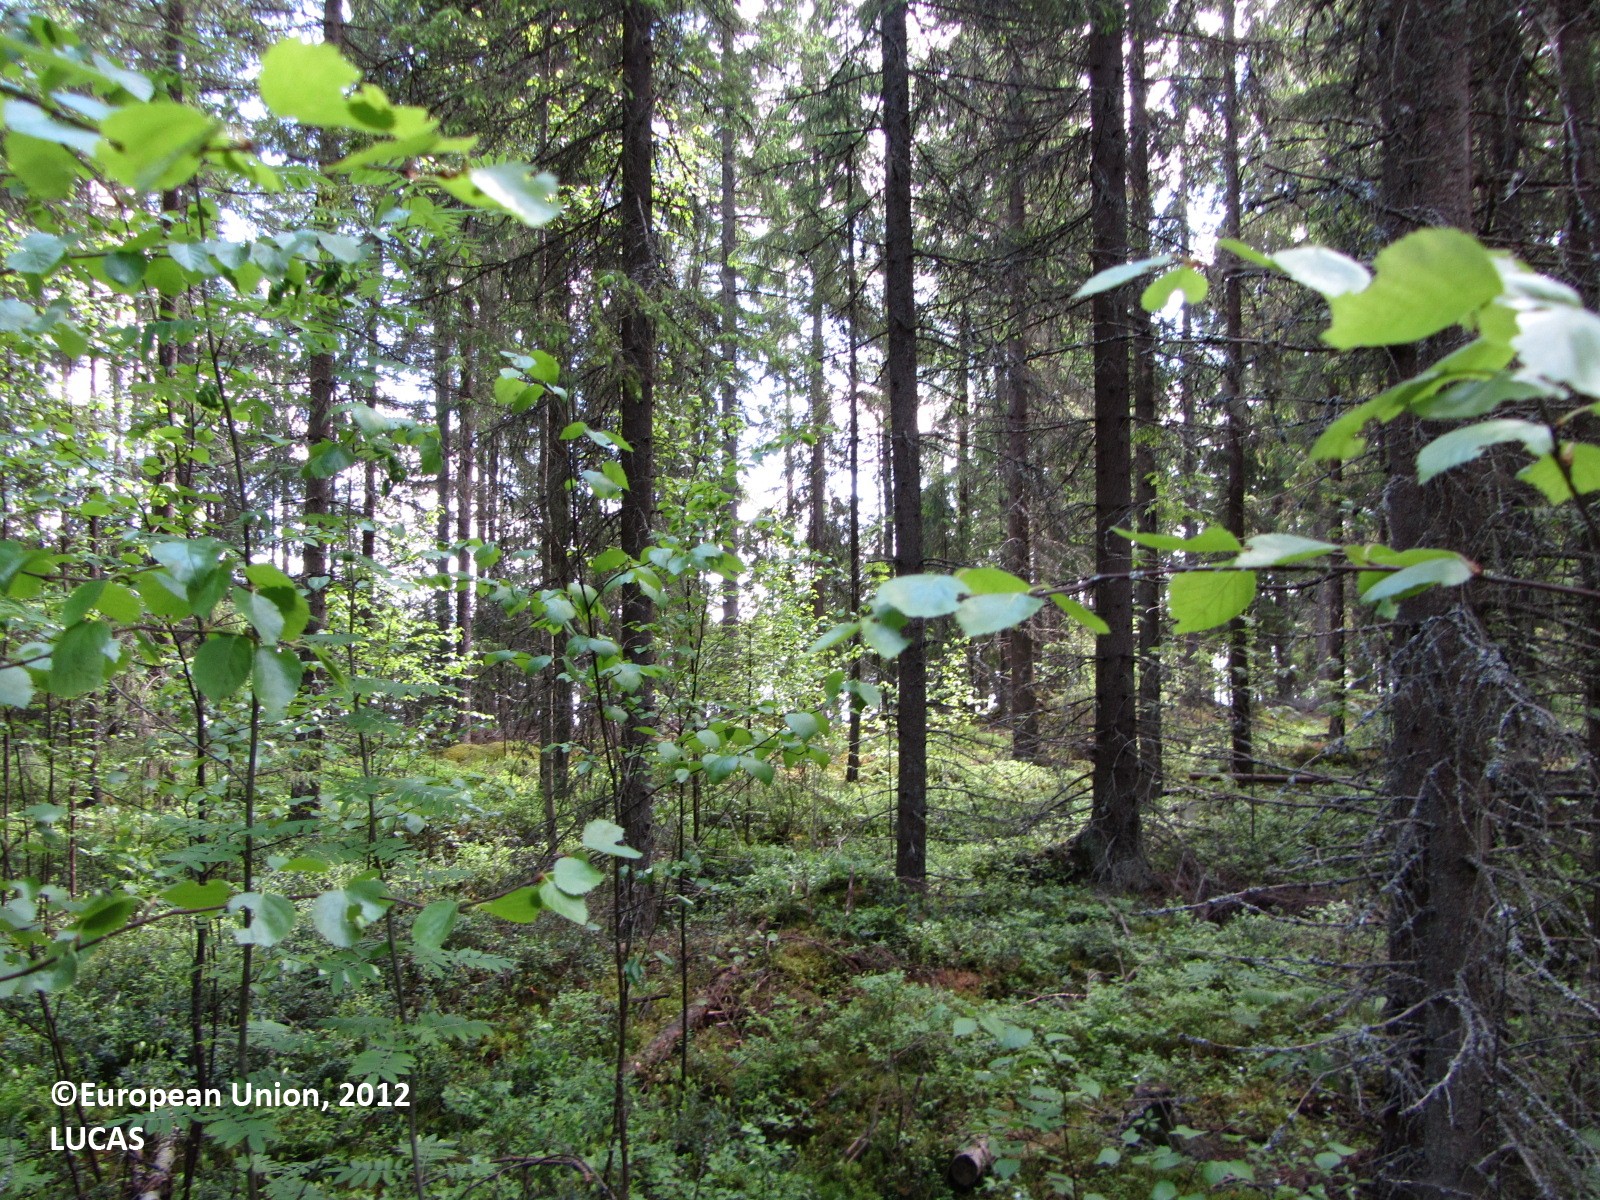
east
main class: Woodland
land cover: Spruce dominated mixed woodland
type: boreal forest
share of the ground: 50 - 75 %
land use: Forestry
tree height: > 5 m
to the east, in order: Spruce dominated mixed woodland; Tracks; Spruce dominated mixed woodland; Inland water bodies
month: June
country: FI
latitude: 62.0253
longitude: 24.9519
